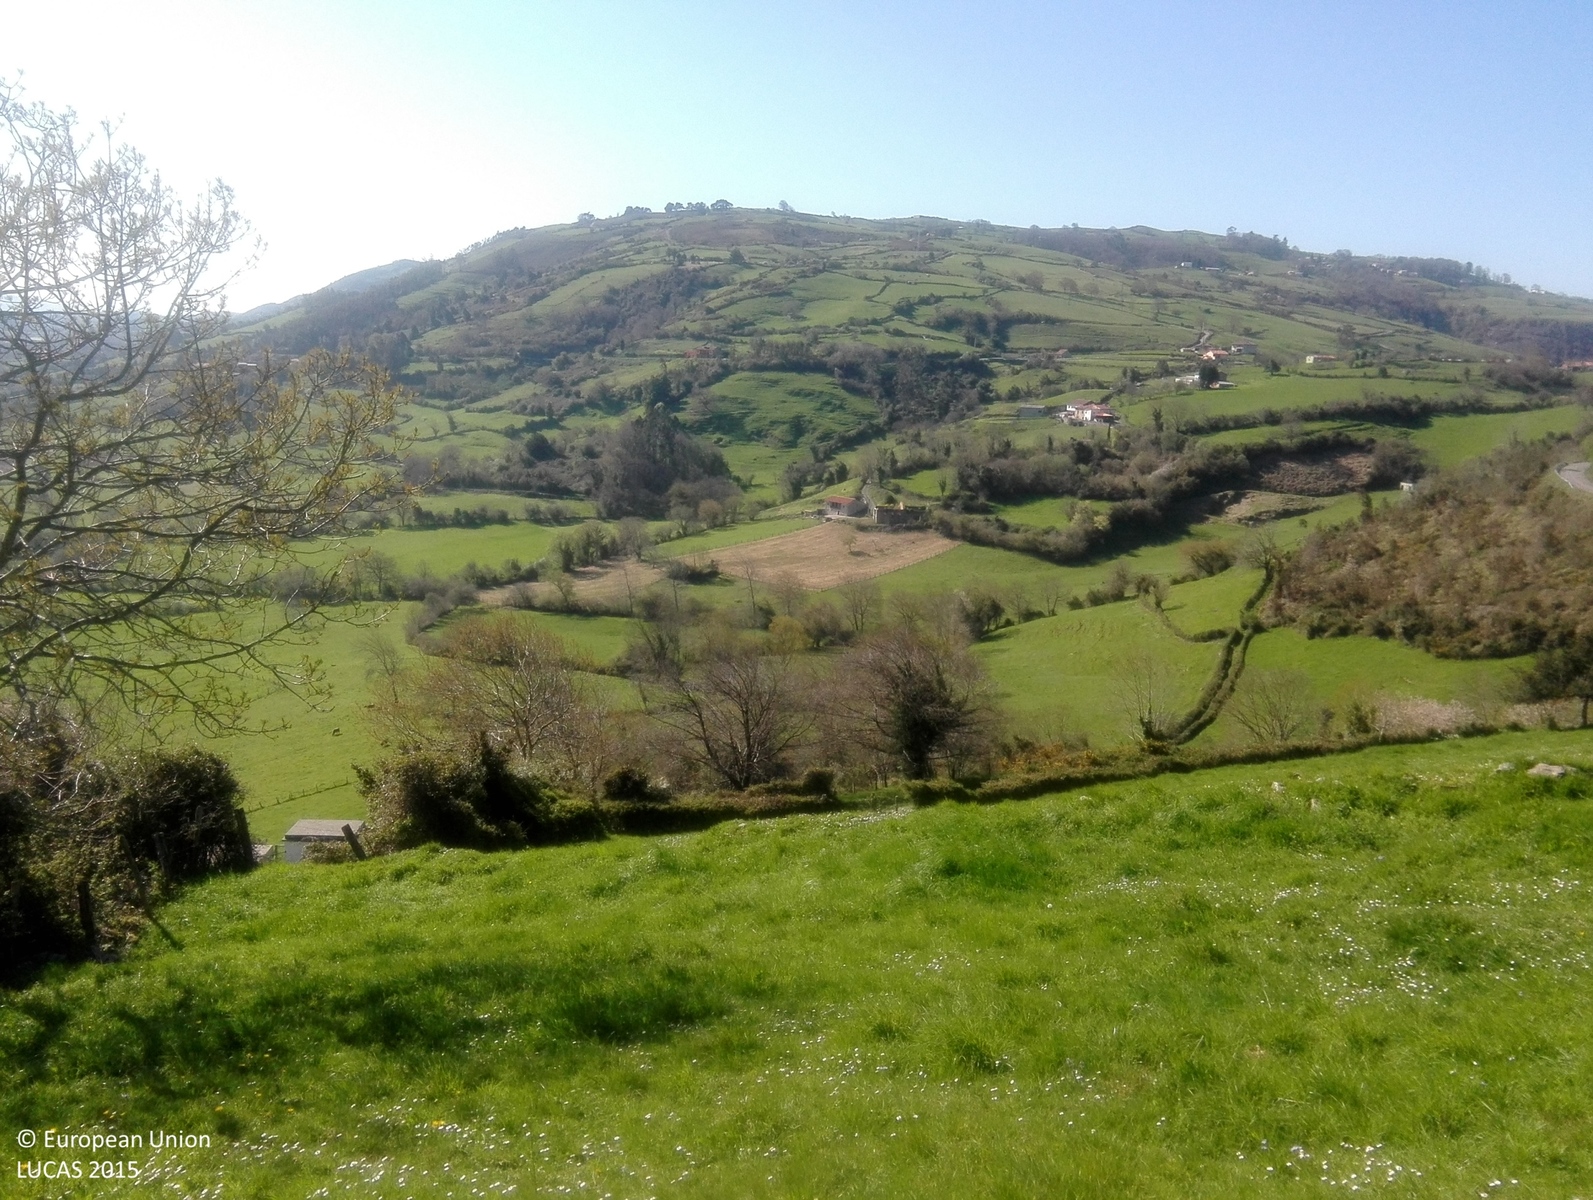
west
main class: Grassland
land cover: Grassland without tree/shrub cover
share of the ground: > 75 %
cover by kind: herbaceous plants 100 %
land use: Agriculture (excluding fallow land and kitchen gardens)
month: April
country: ES
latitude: 43.4149
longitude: -5.5061
